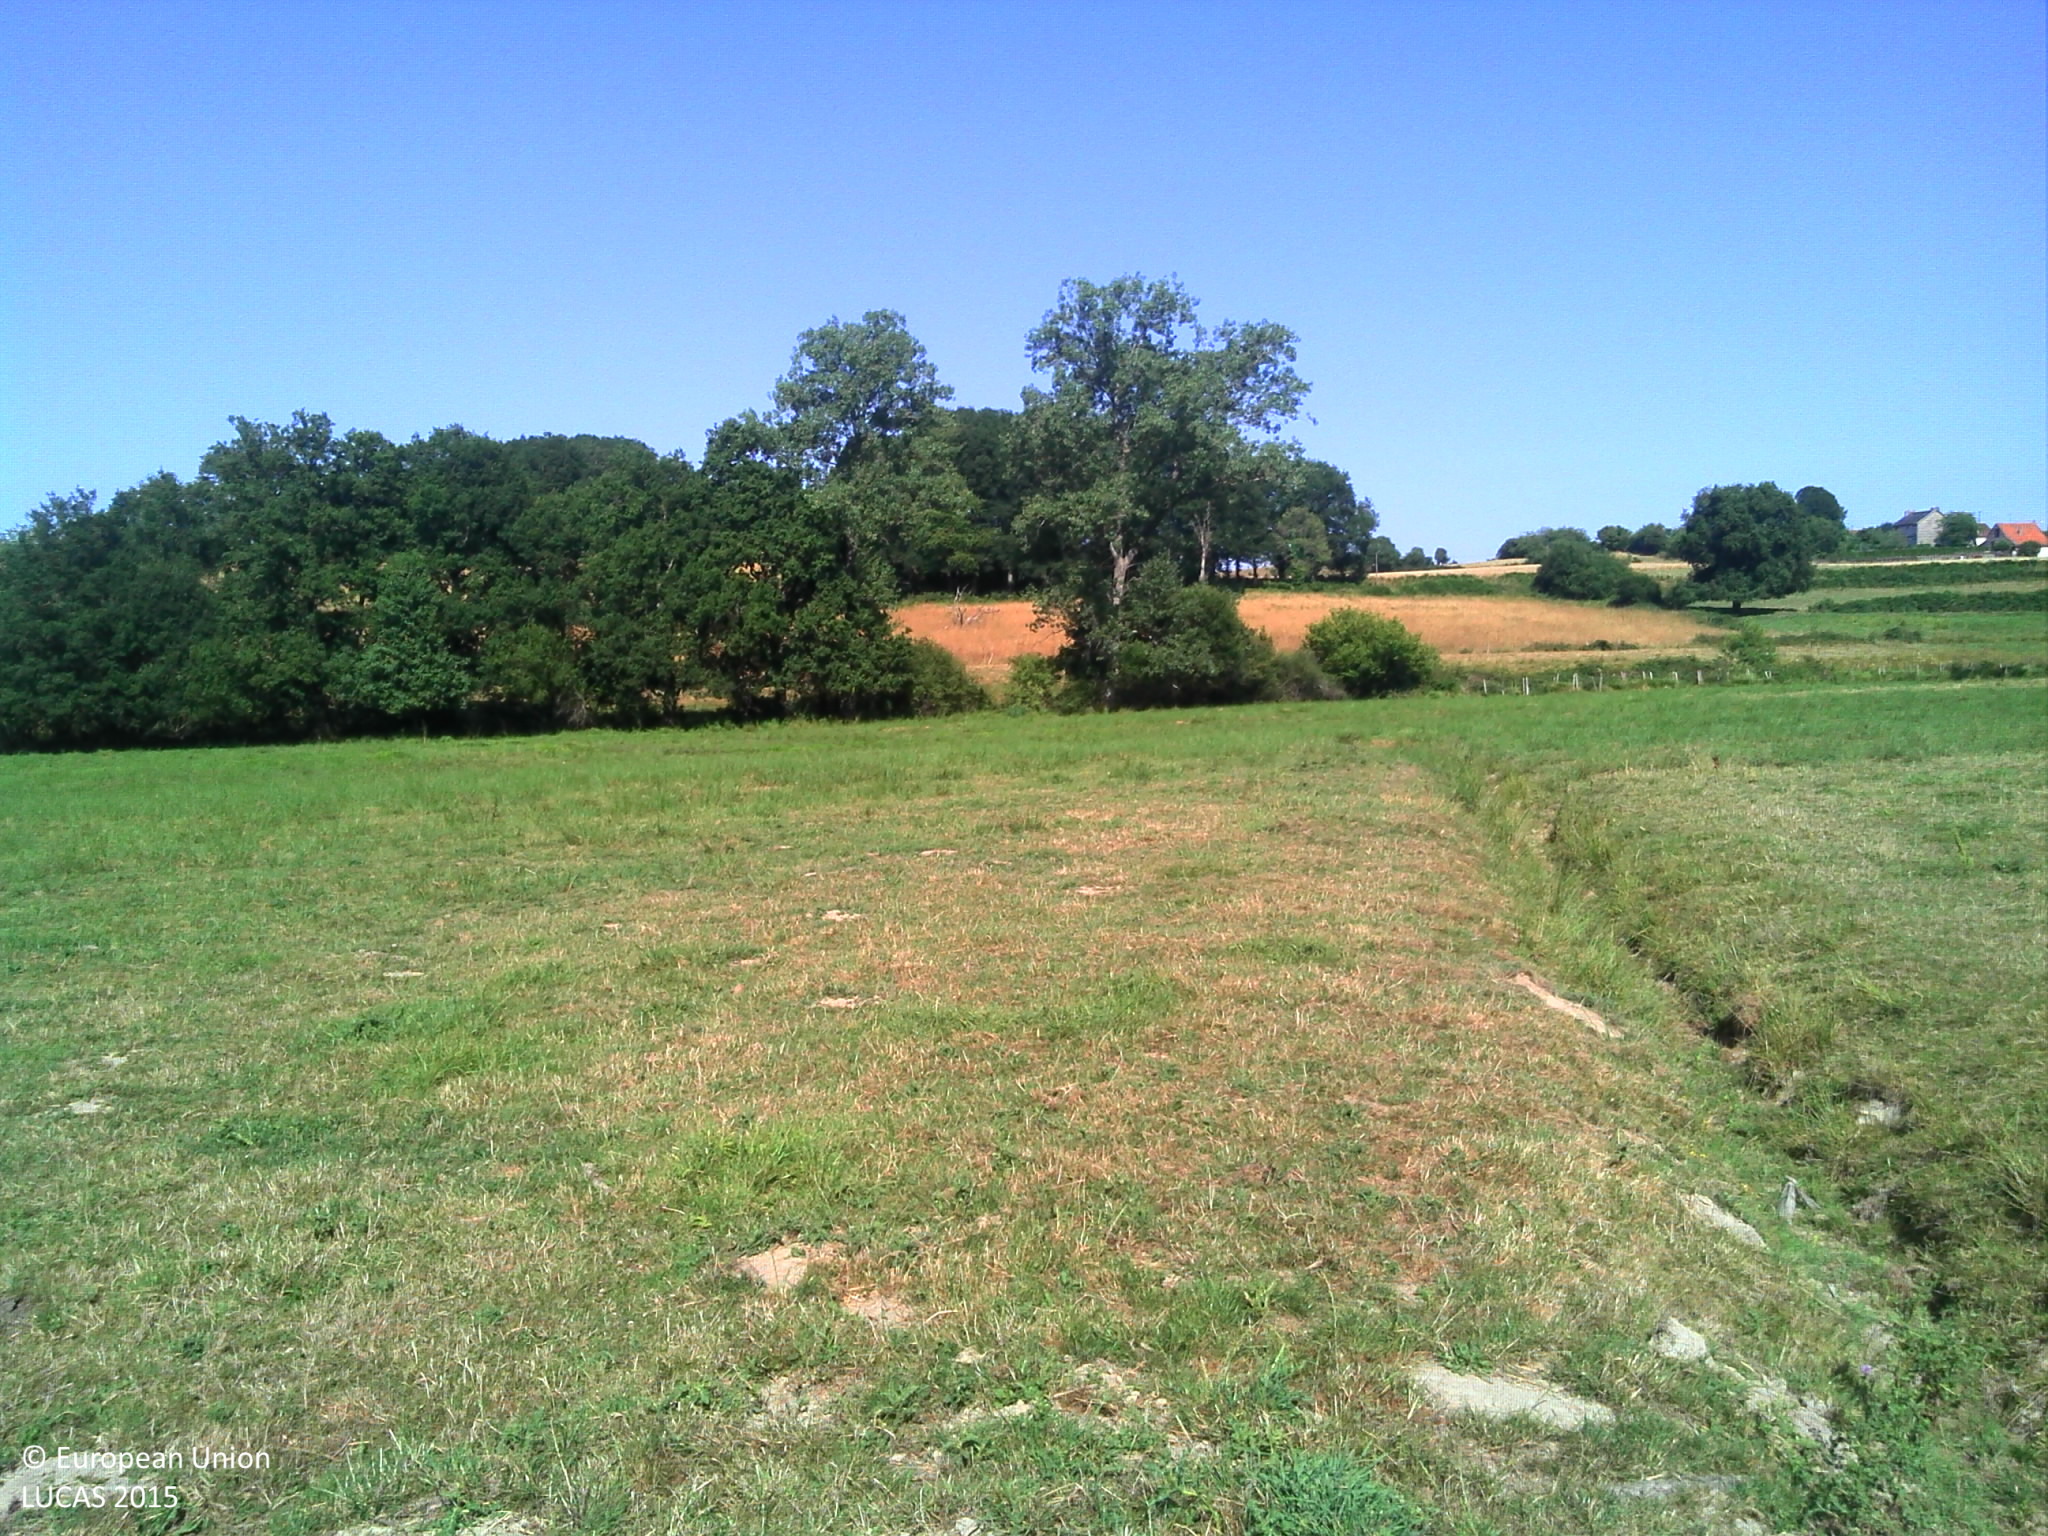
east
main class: Grassland
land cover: Grassland without tree/shrub cover
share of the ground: > 75 %
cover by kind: herbaceous plants 95 %, shrubs 5 %
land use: Agriculture (excluding fallow land and kitchen gardens)
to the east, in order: Grassland without tree/shrub cover; Ditches and canals; Grassland without tree/shrub cover; Rivers and streams; Fences; Managed hedges; Grassland without tree/shrub cover; Fences; Spontaneously vegetated surfaces; Fences; Managed hedges
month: July
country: FR
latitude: 46.1384
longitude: 1.7207
